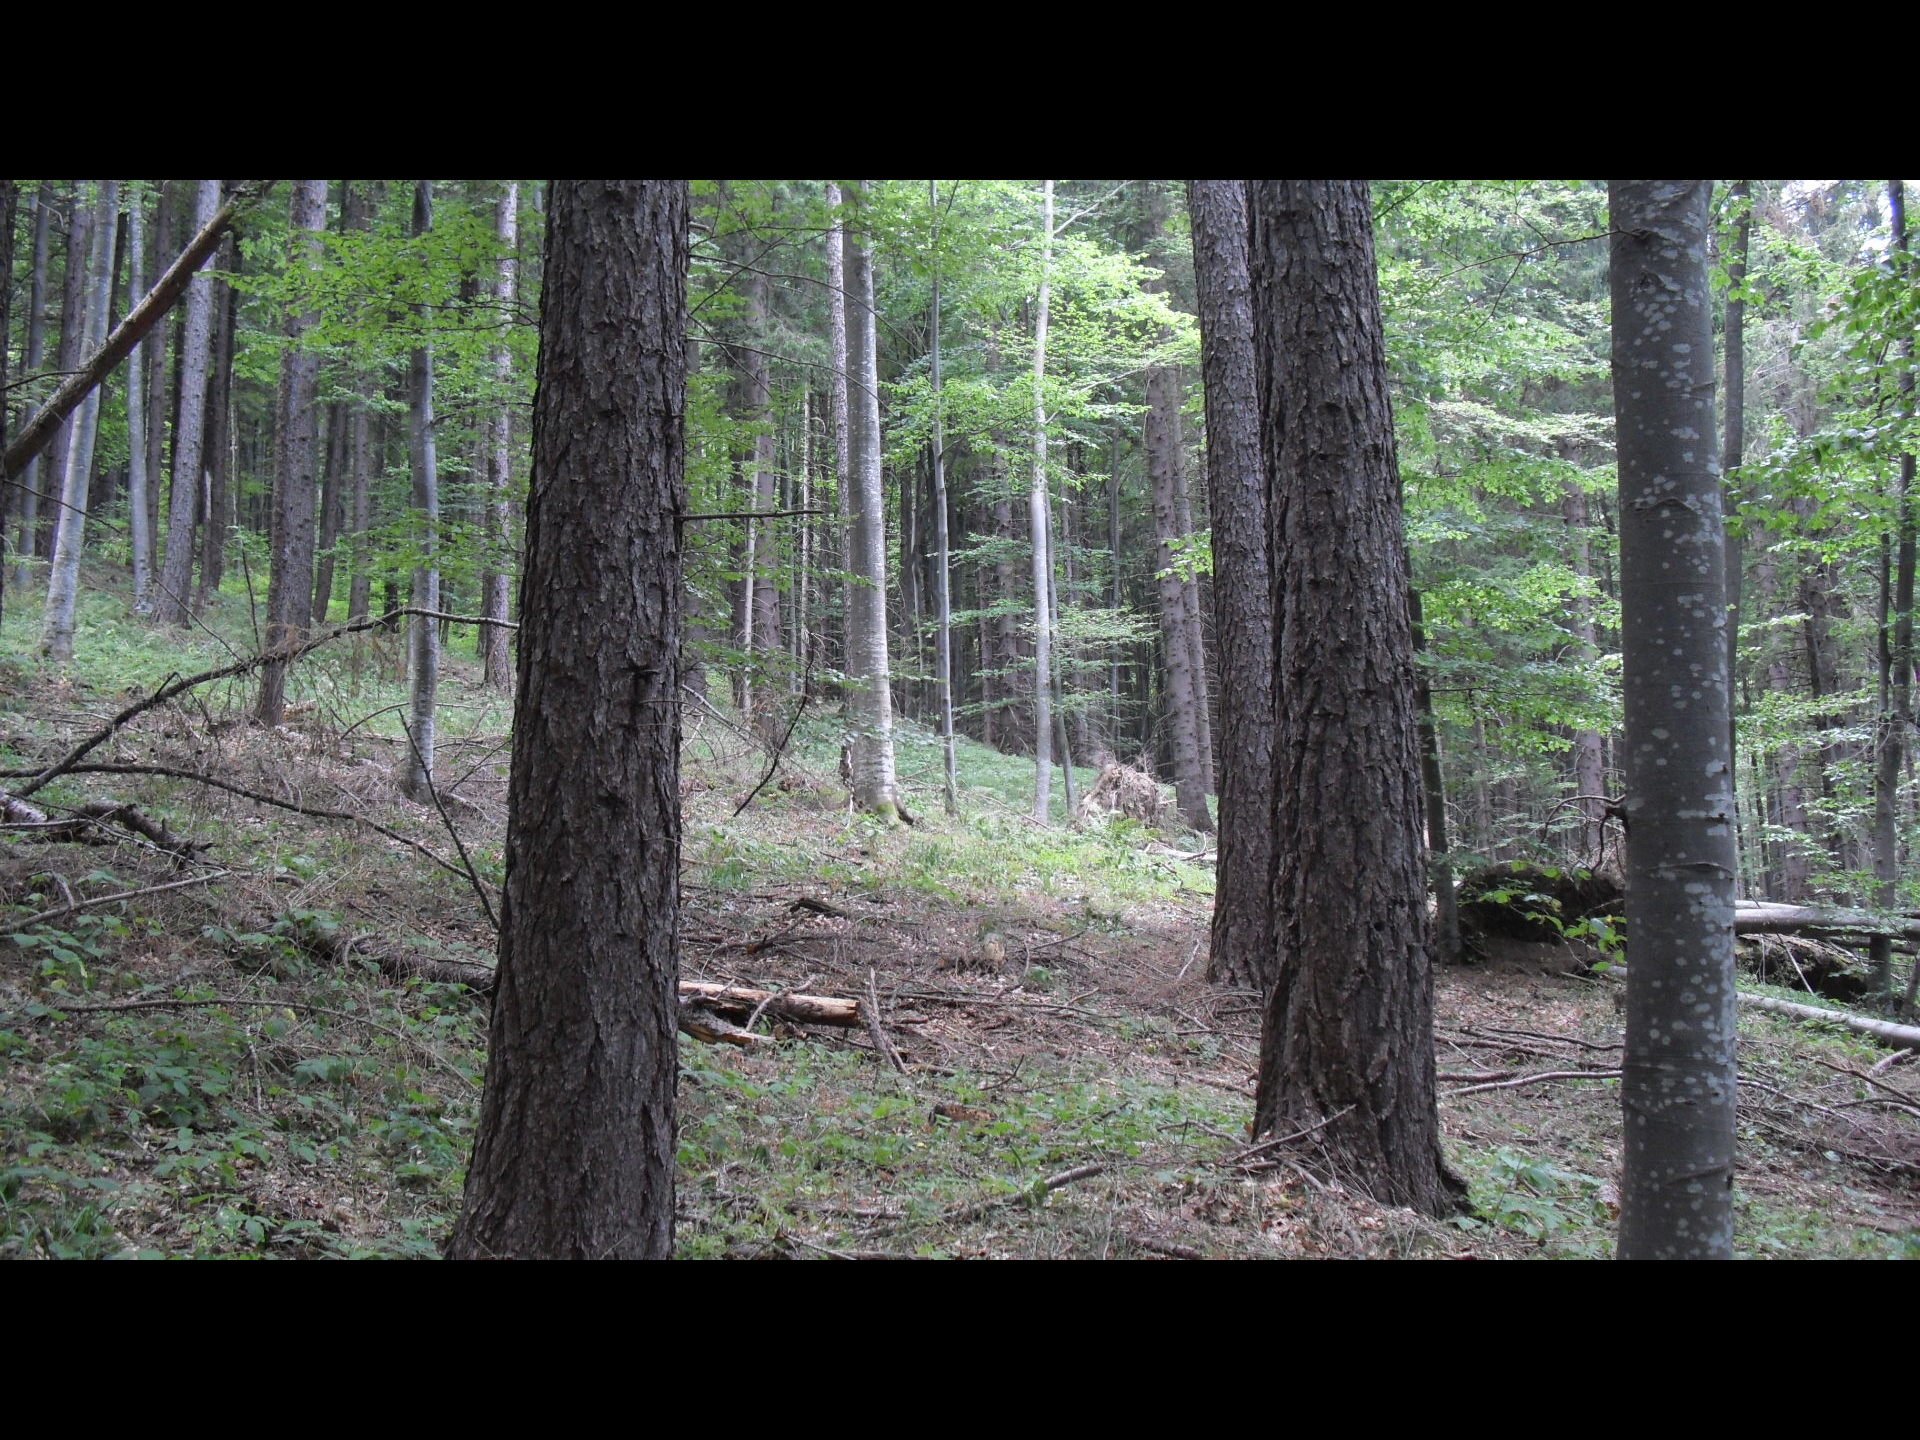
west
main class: Woodland
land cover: Other mixed woodland
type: hemiboreal forest and nemoral coniferous forest and mixed broadleaved-coniferous forest
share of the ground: > 75 %
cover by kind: coniferous forest trees 50 %, broadleaved forest trees 40 %, herbaceous plants 10 %
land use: Forestry
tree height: > 5 m
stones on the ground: < 10 %
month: August
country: BG
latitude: 43.1437
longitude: 23.1554
